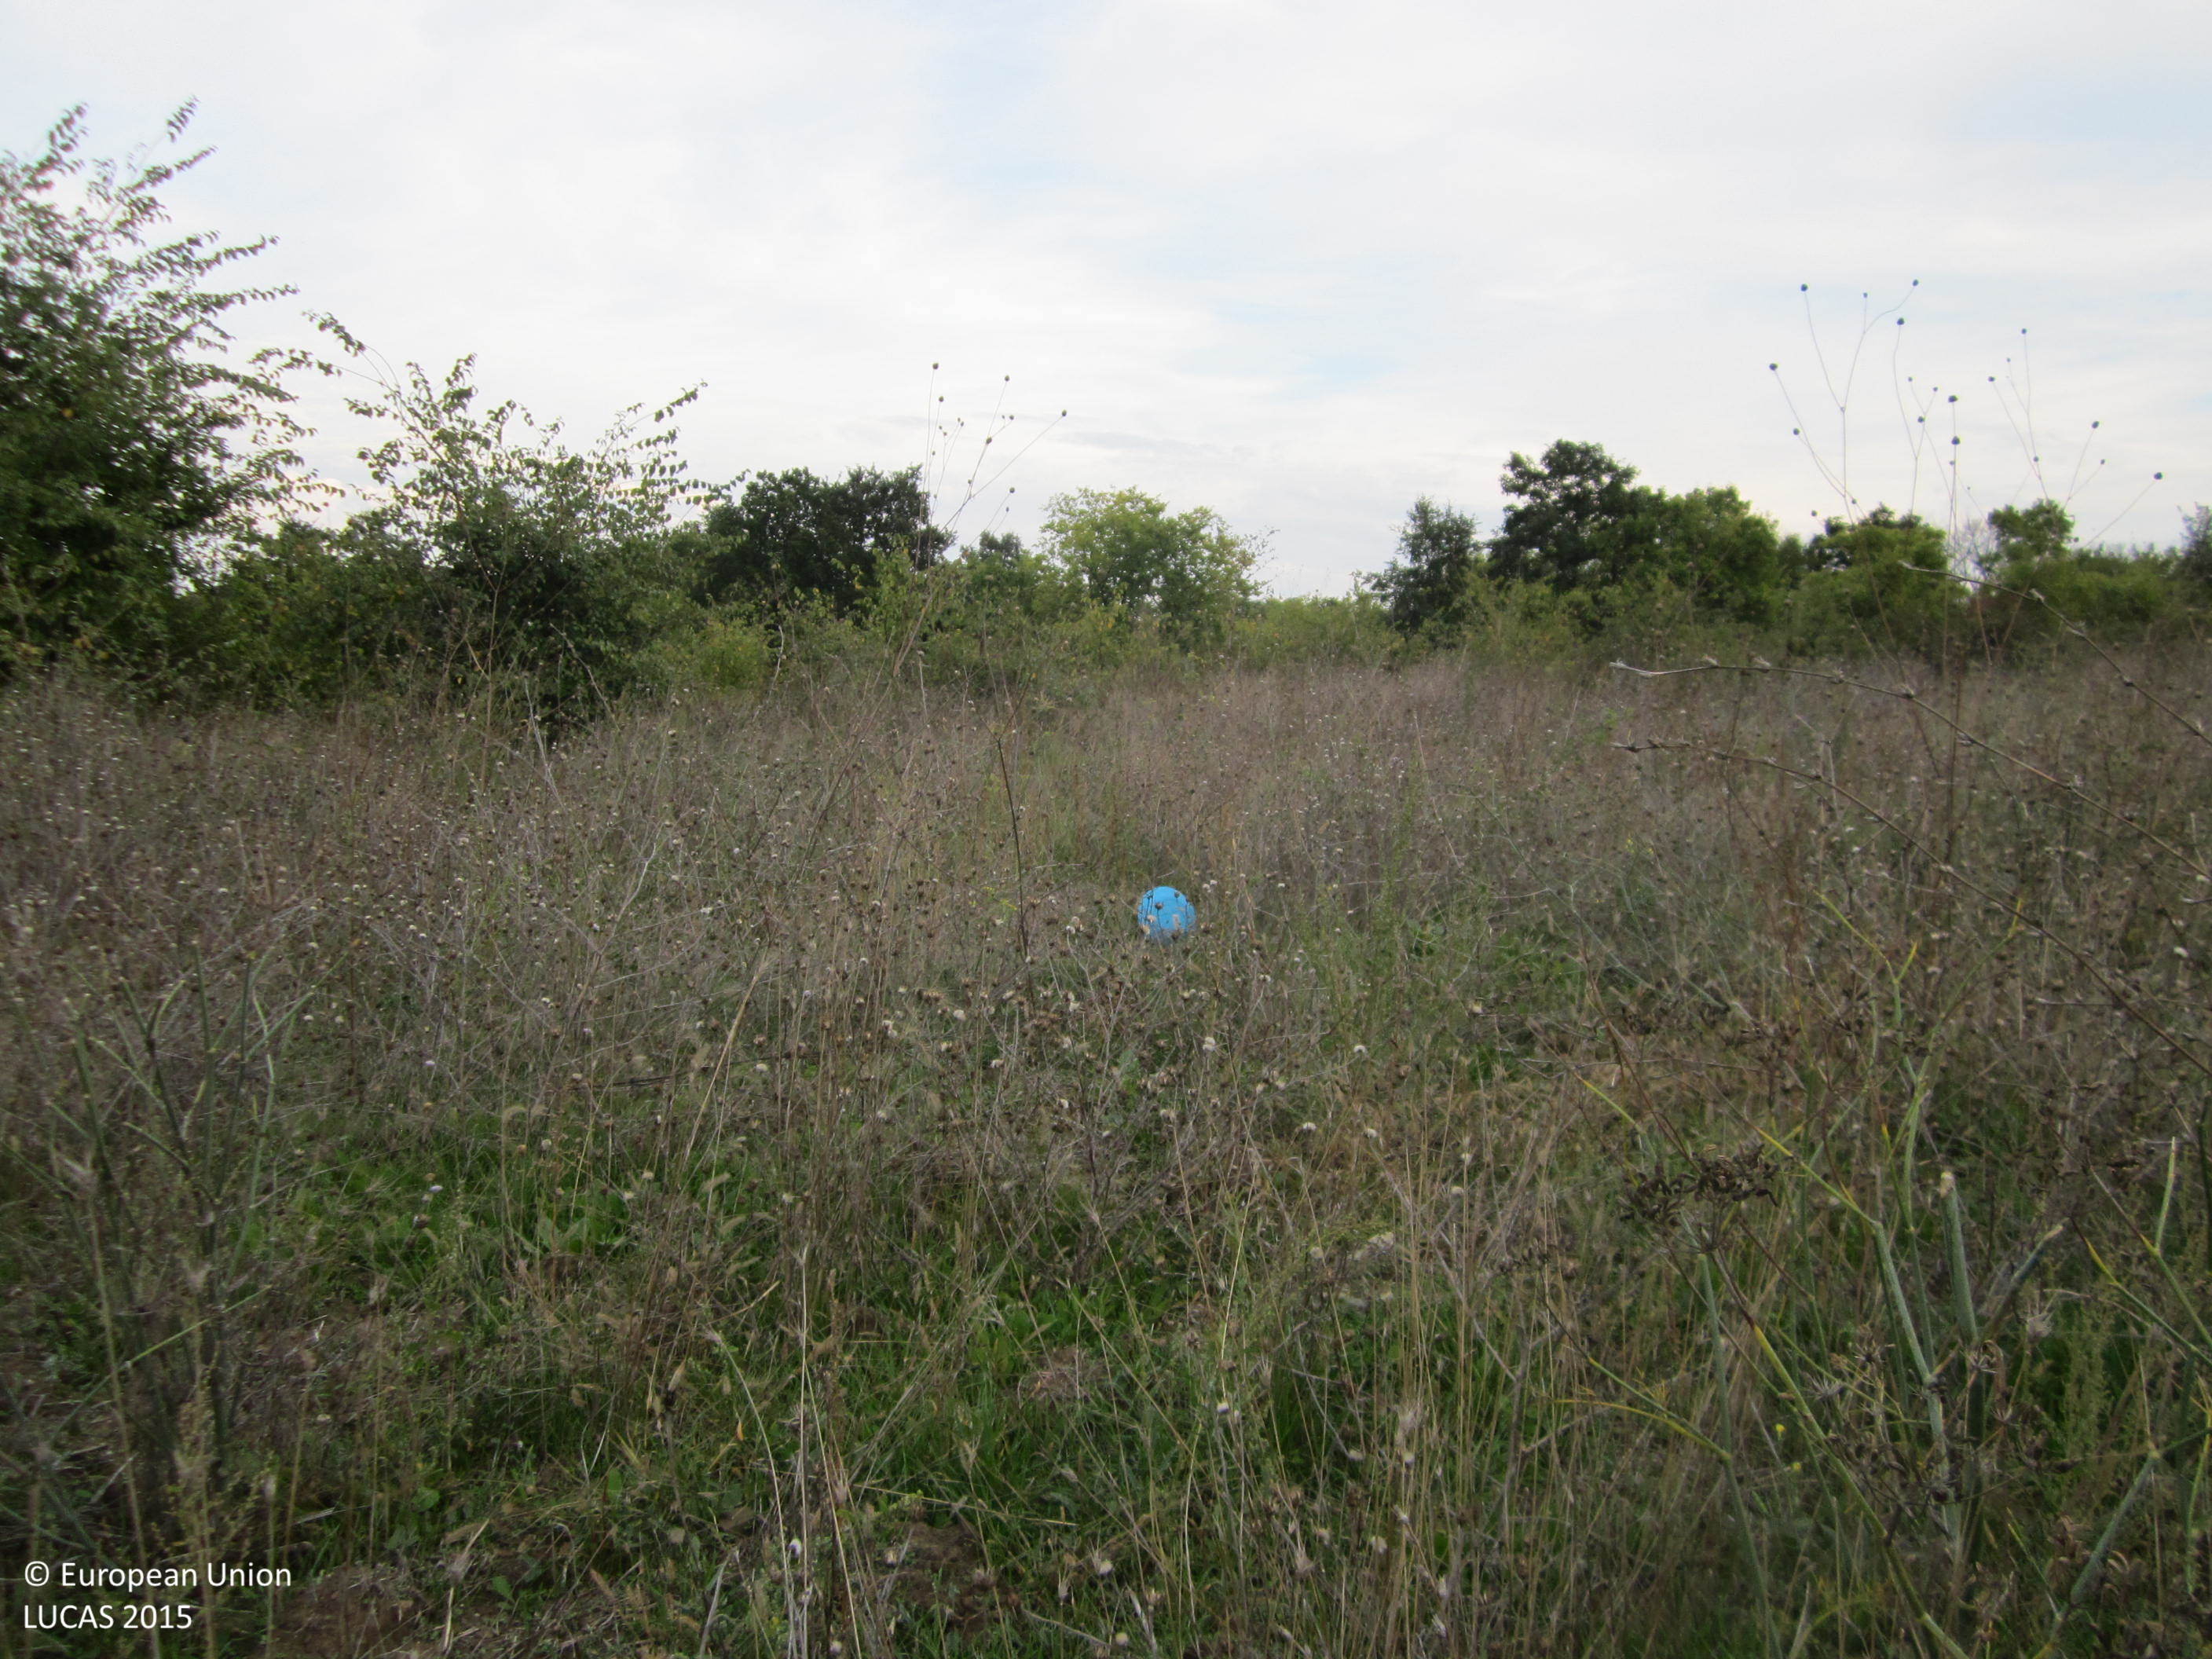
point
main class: Grassland
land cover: Grassland without tree/shrub cover
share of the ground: > 75 %
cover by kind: herbaceous plants 100 %
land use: Agriculture (excluding fallow land and kitchen gardens)
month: October
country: BG
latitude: 42.7124
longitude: 26.7932
